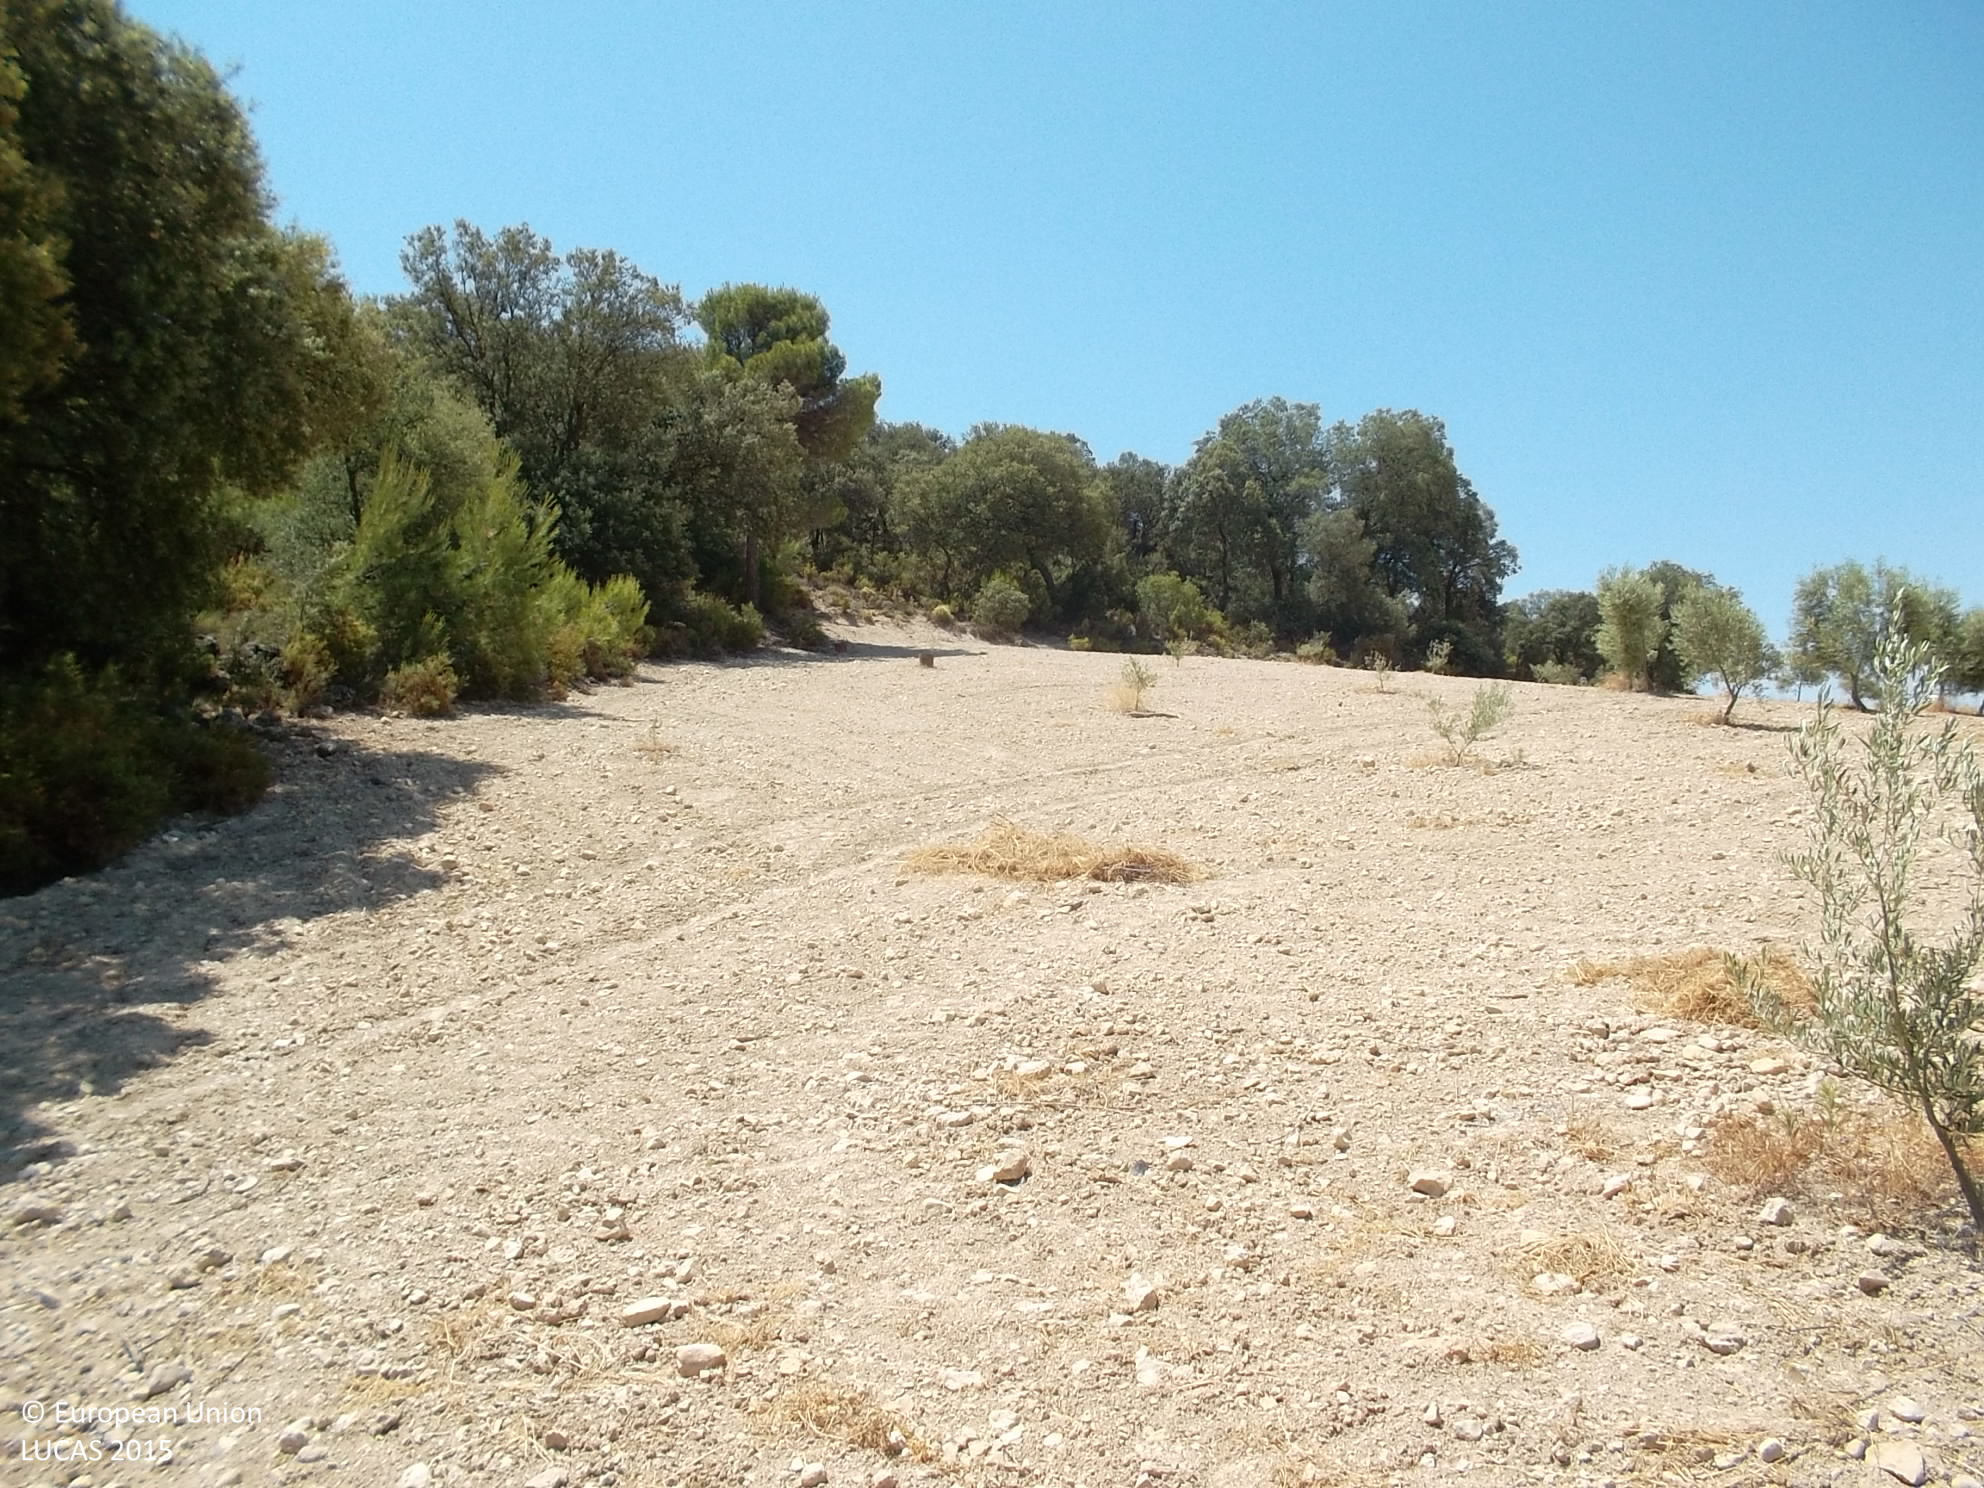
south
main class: Cropland
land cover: Olive groves
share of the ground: 10 - 25 %
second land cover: Other bare soil
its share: > 75 %
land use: Agriculture (excluding fallow land and kitchen gardens)
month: June
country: ES
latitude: 37.6659
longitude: -3.3378
